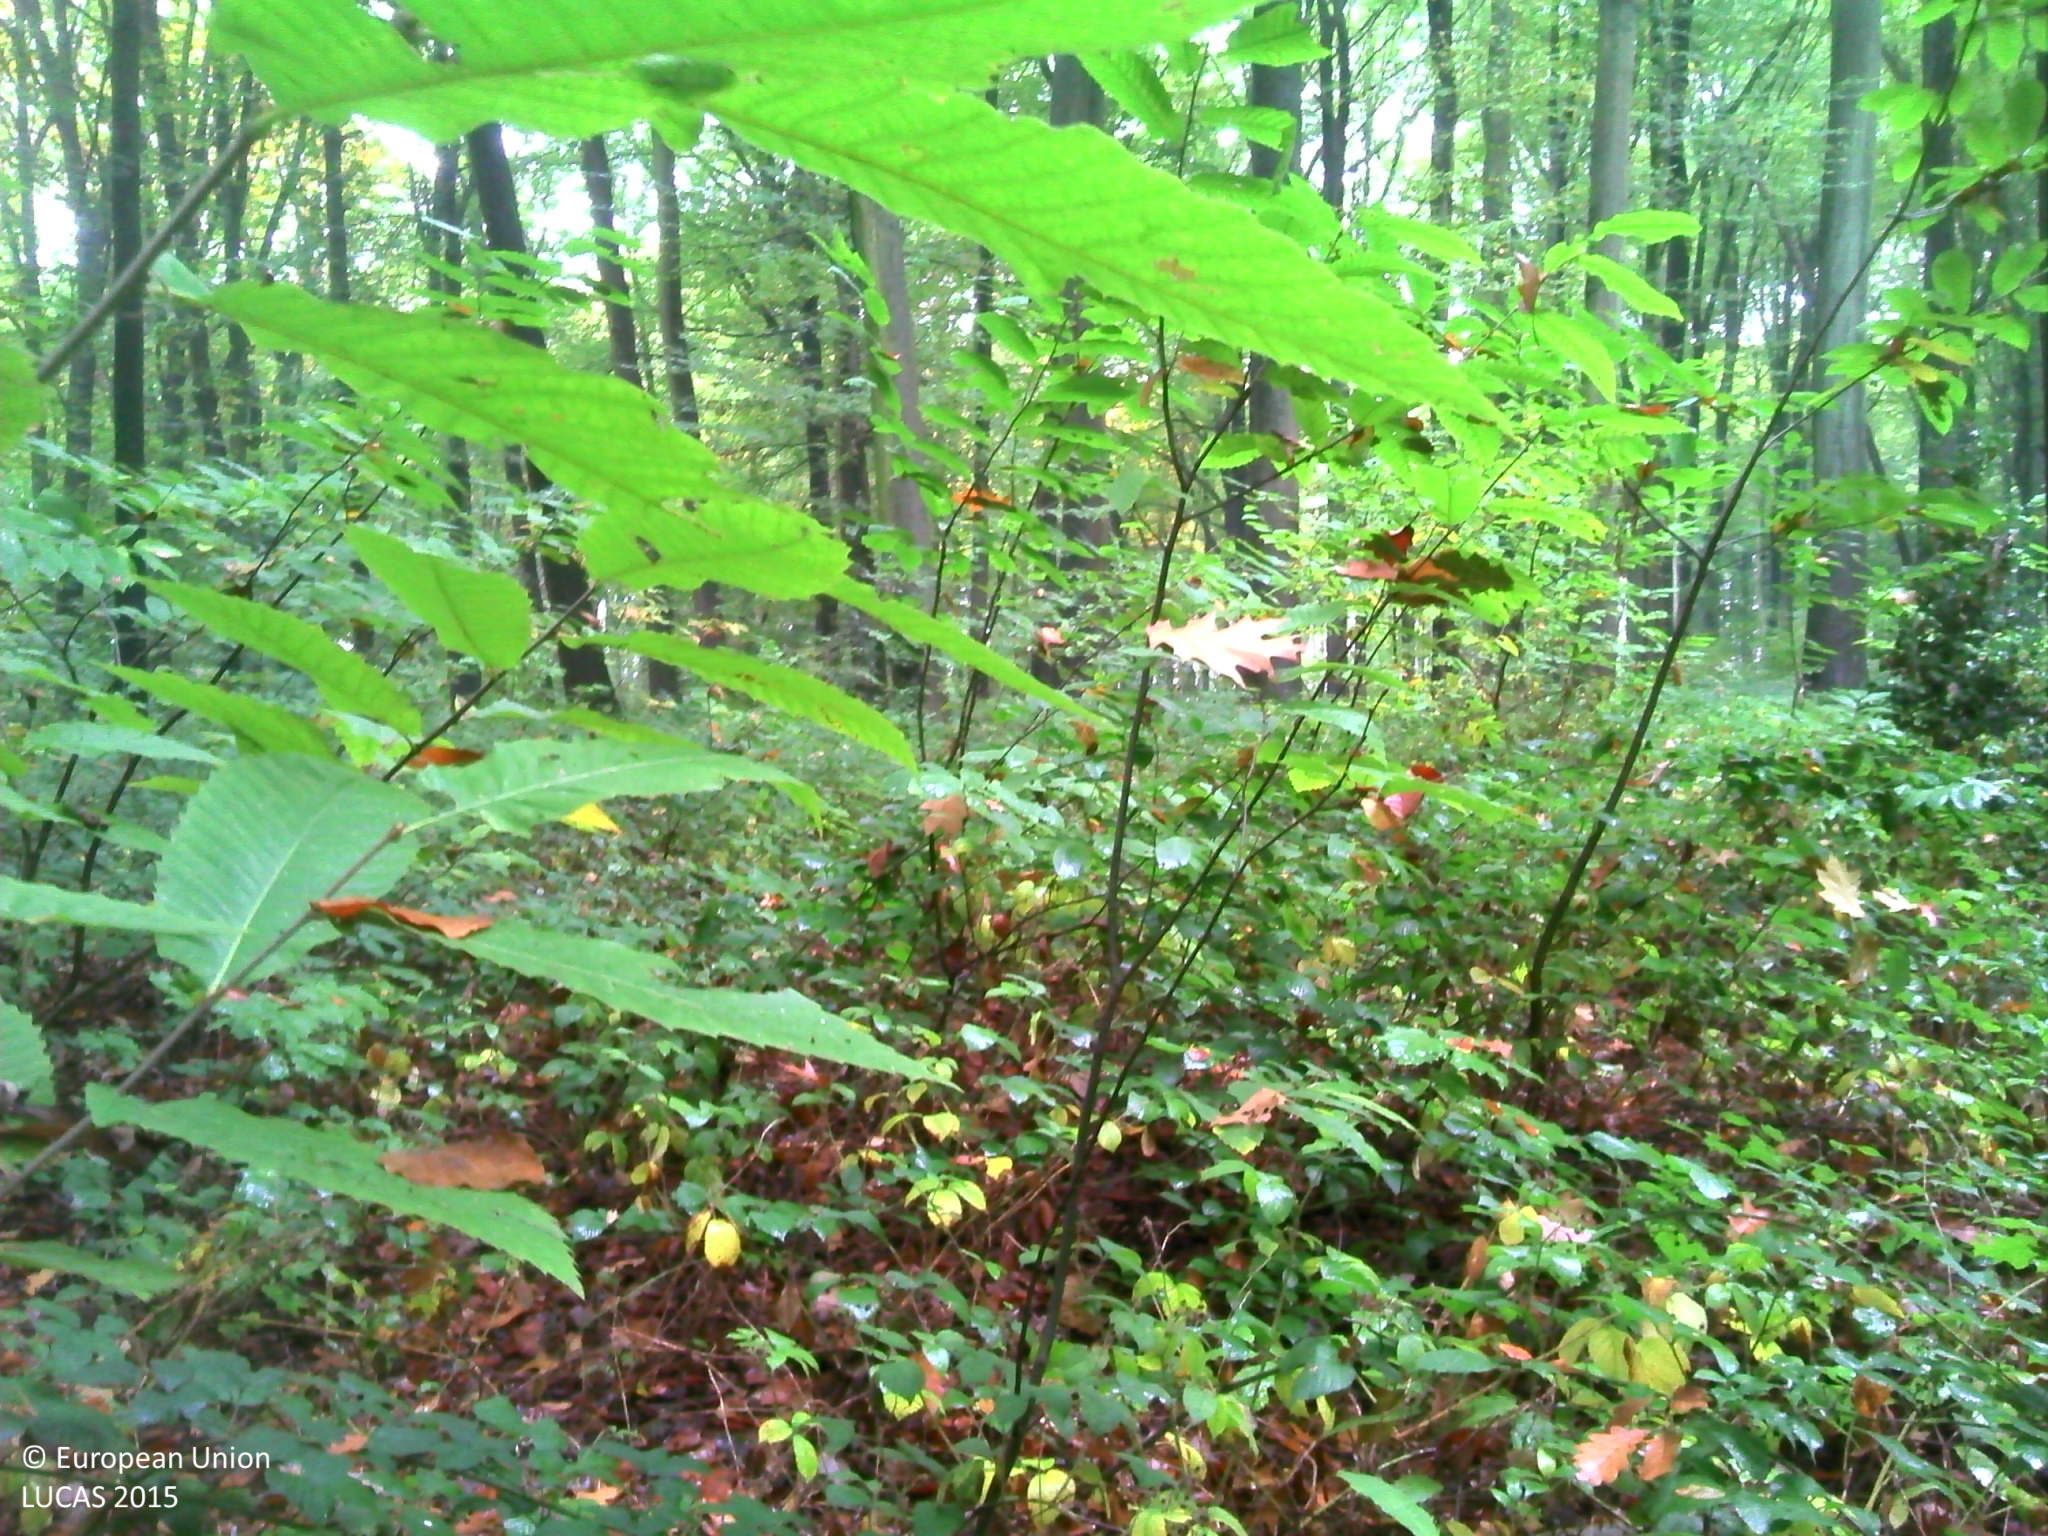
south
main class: Woodland
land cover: Broadleaved woodland
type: beech forest
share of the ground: > 75 %
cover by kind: broadleaved forest trees 80 %, shrubs 10 %, herbaceous plants 10 %
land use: Forestry
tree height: > 5 m
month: October
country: BE
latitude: 50.8651
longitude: 4.5541
